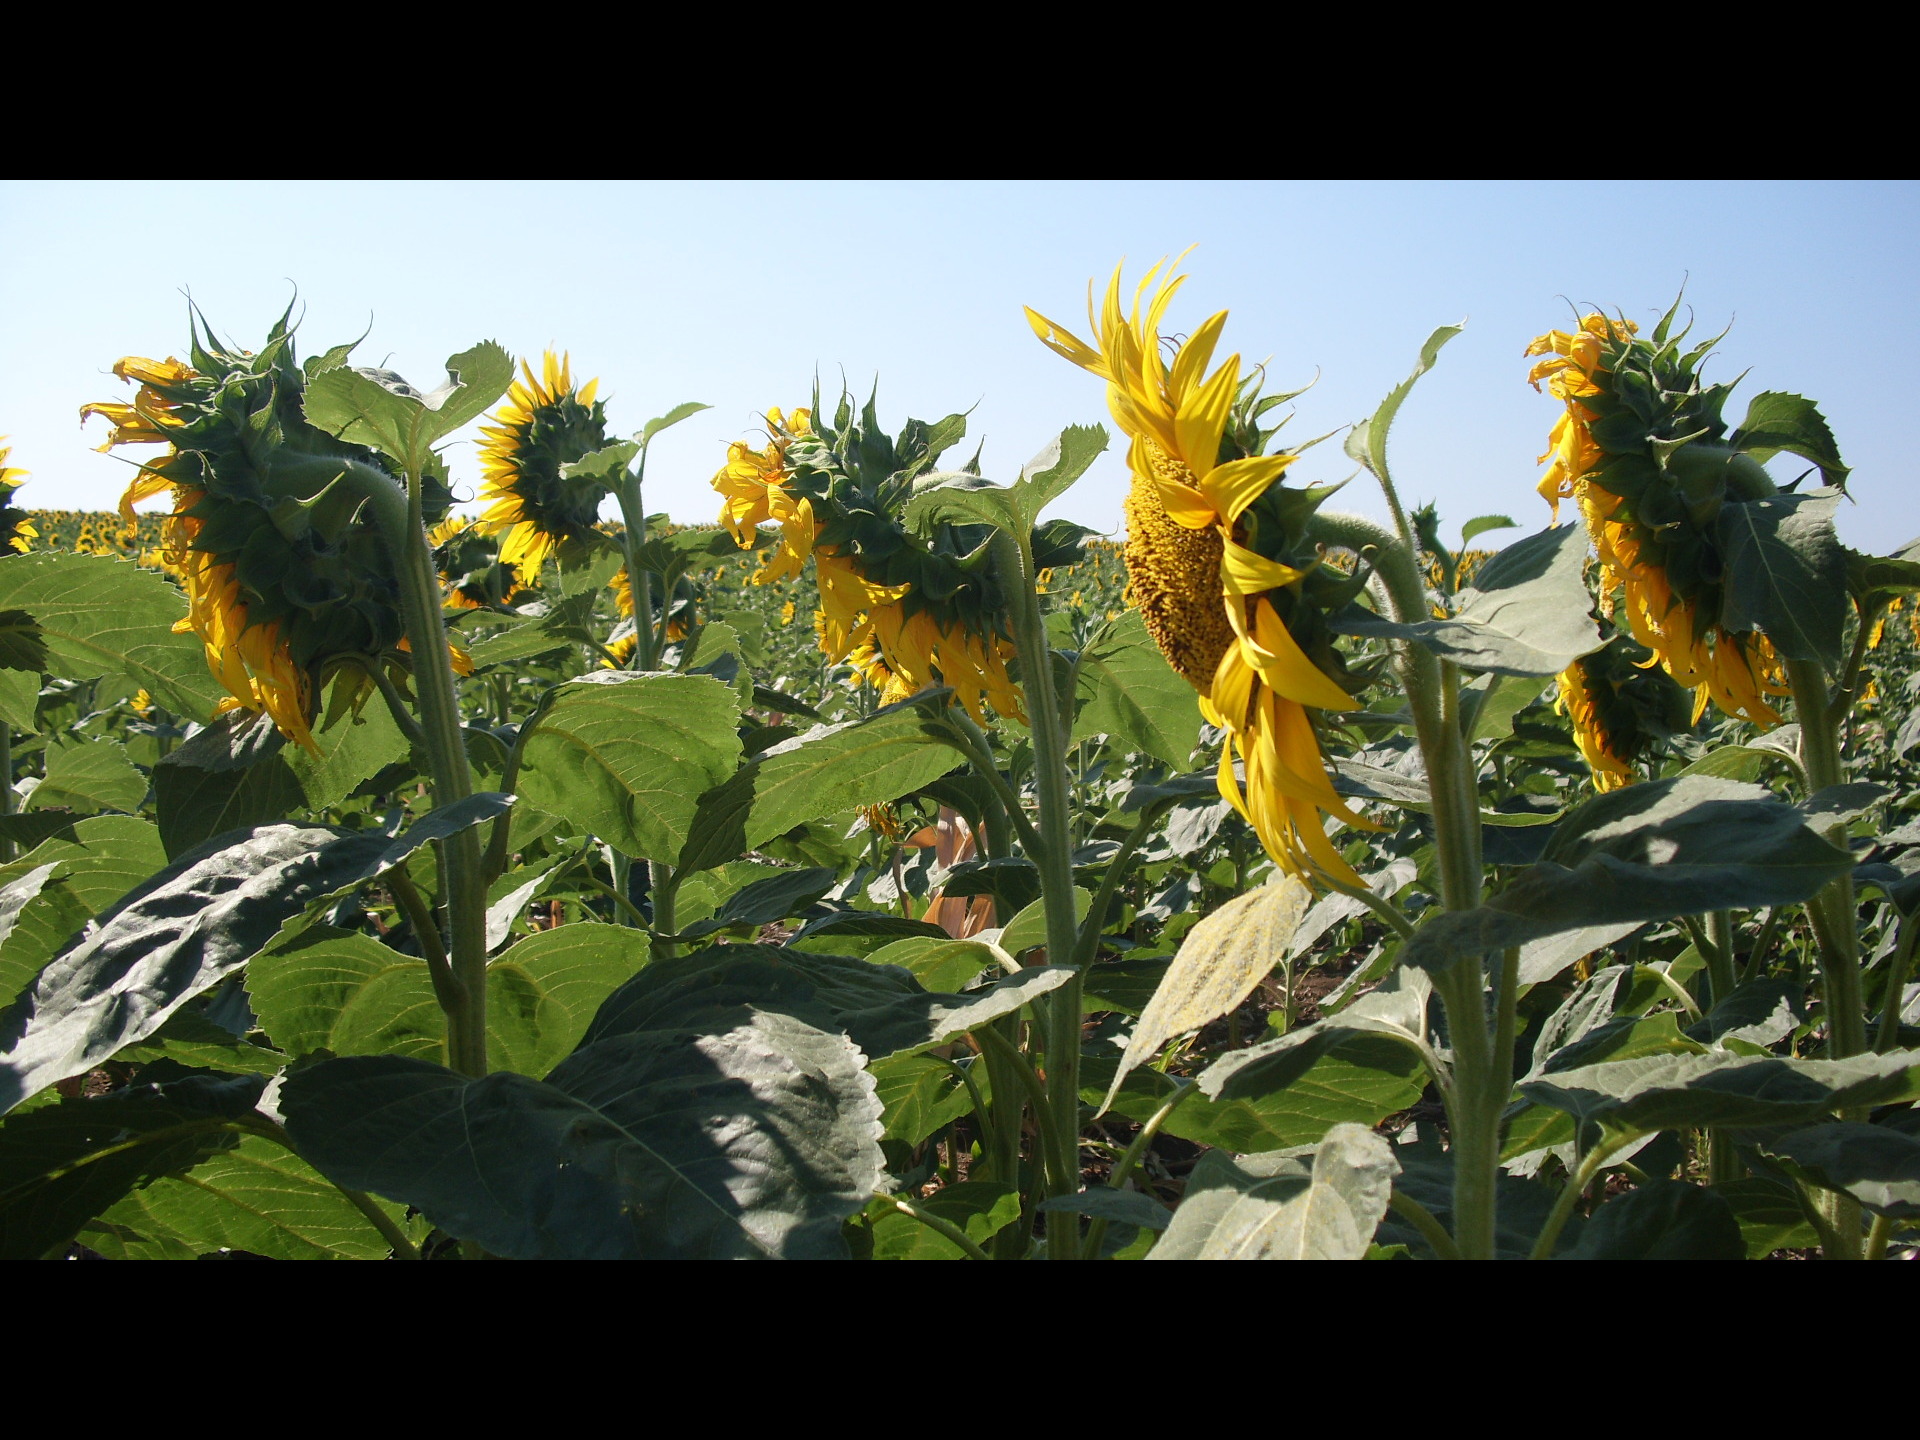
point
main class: Cropland
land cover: Sunflower
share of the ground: > 75 %
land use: Agriculture (excluding fallow land and kitchen gardens)
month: July
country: BG
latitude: 43.8422
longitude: 22.6851
